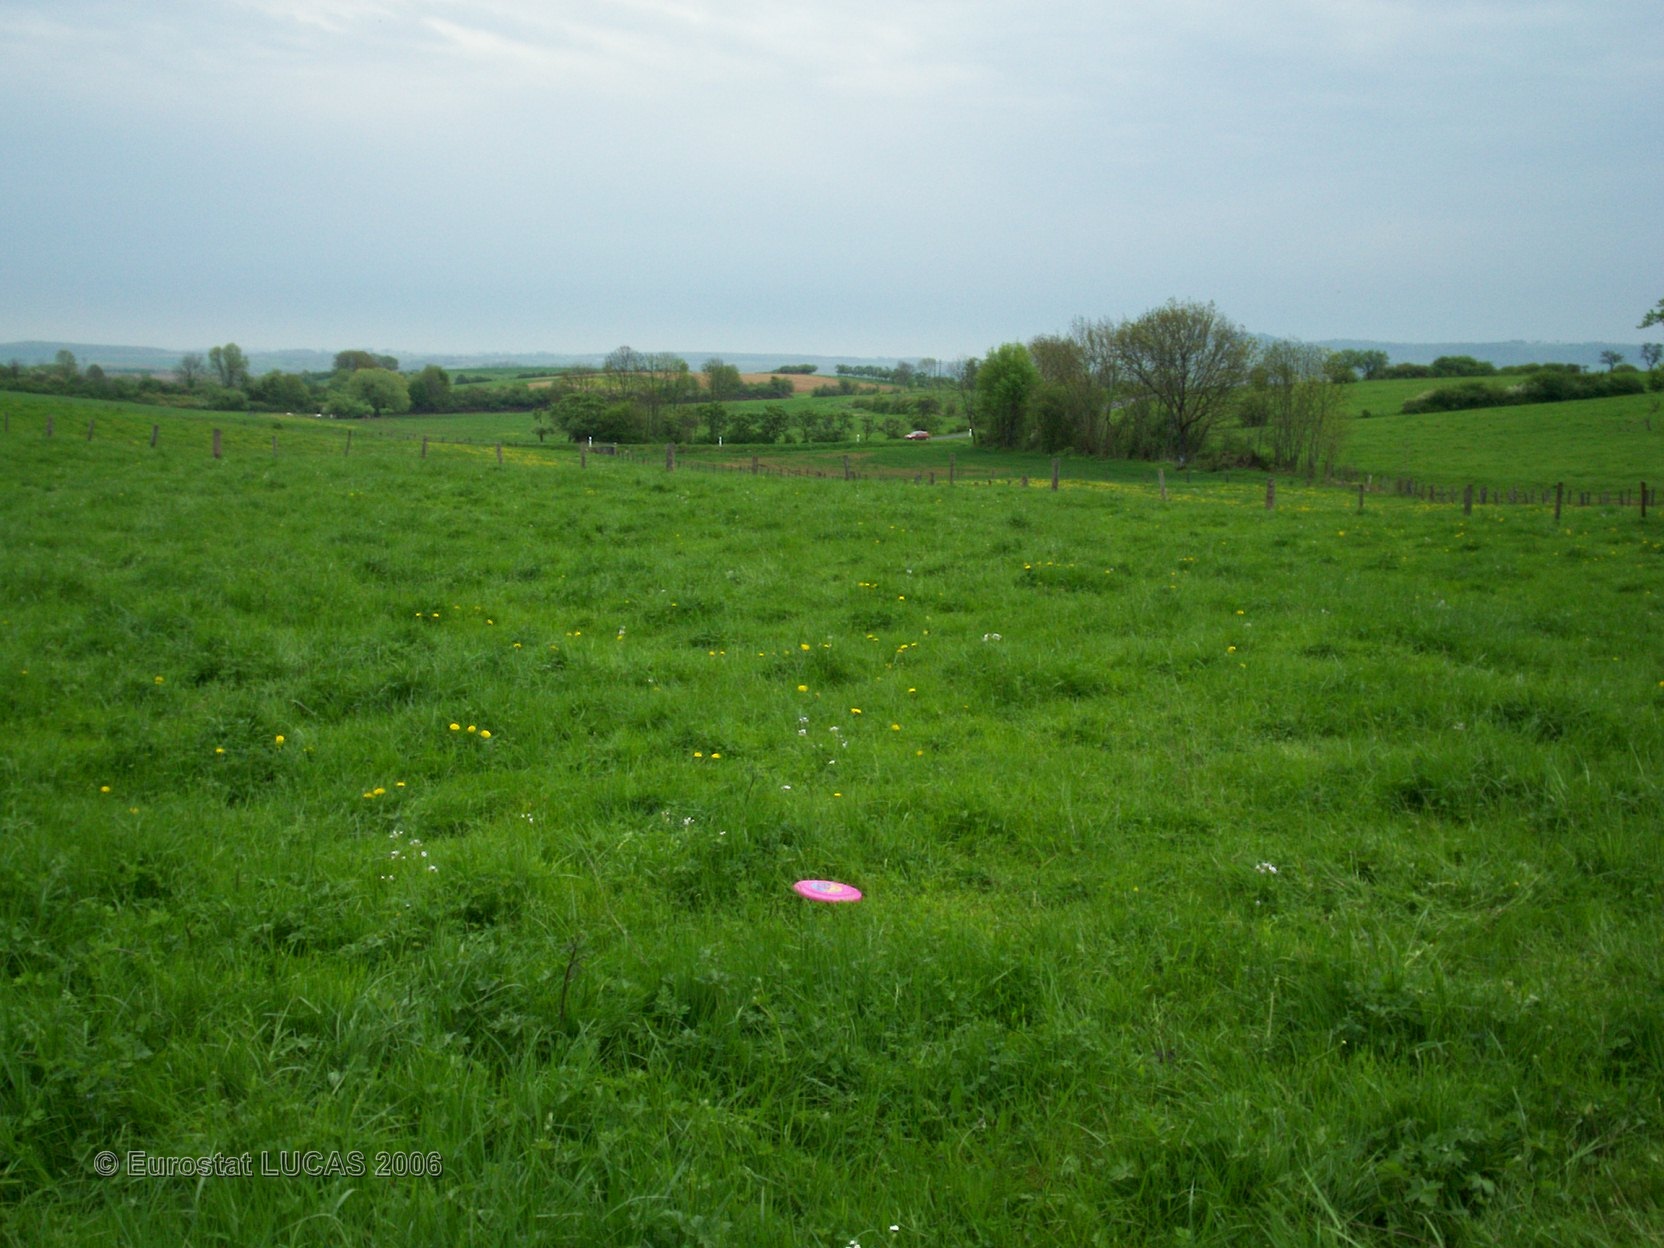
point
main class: Grassland
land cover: Grassland without tree/shrub cover
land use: Agriculture (excluding fallow land and kitchen gardens)
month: May
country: FR
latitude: 48.4387
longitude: 5.9854
